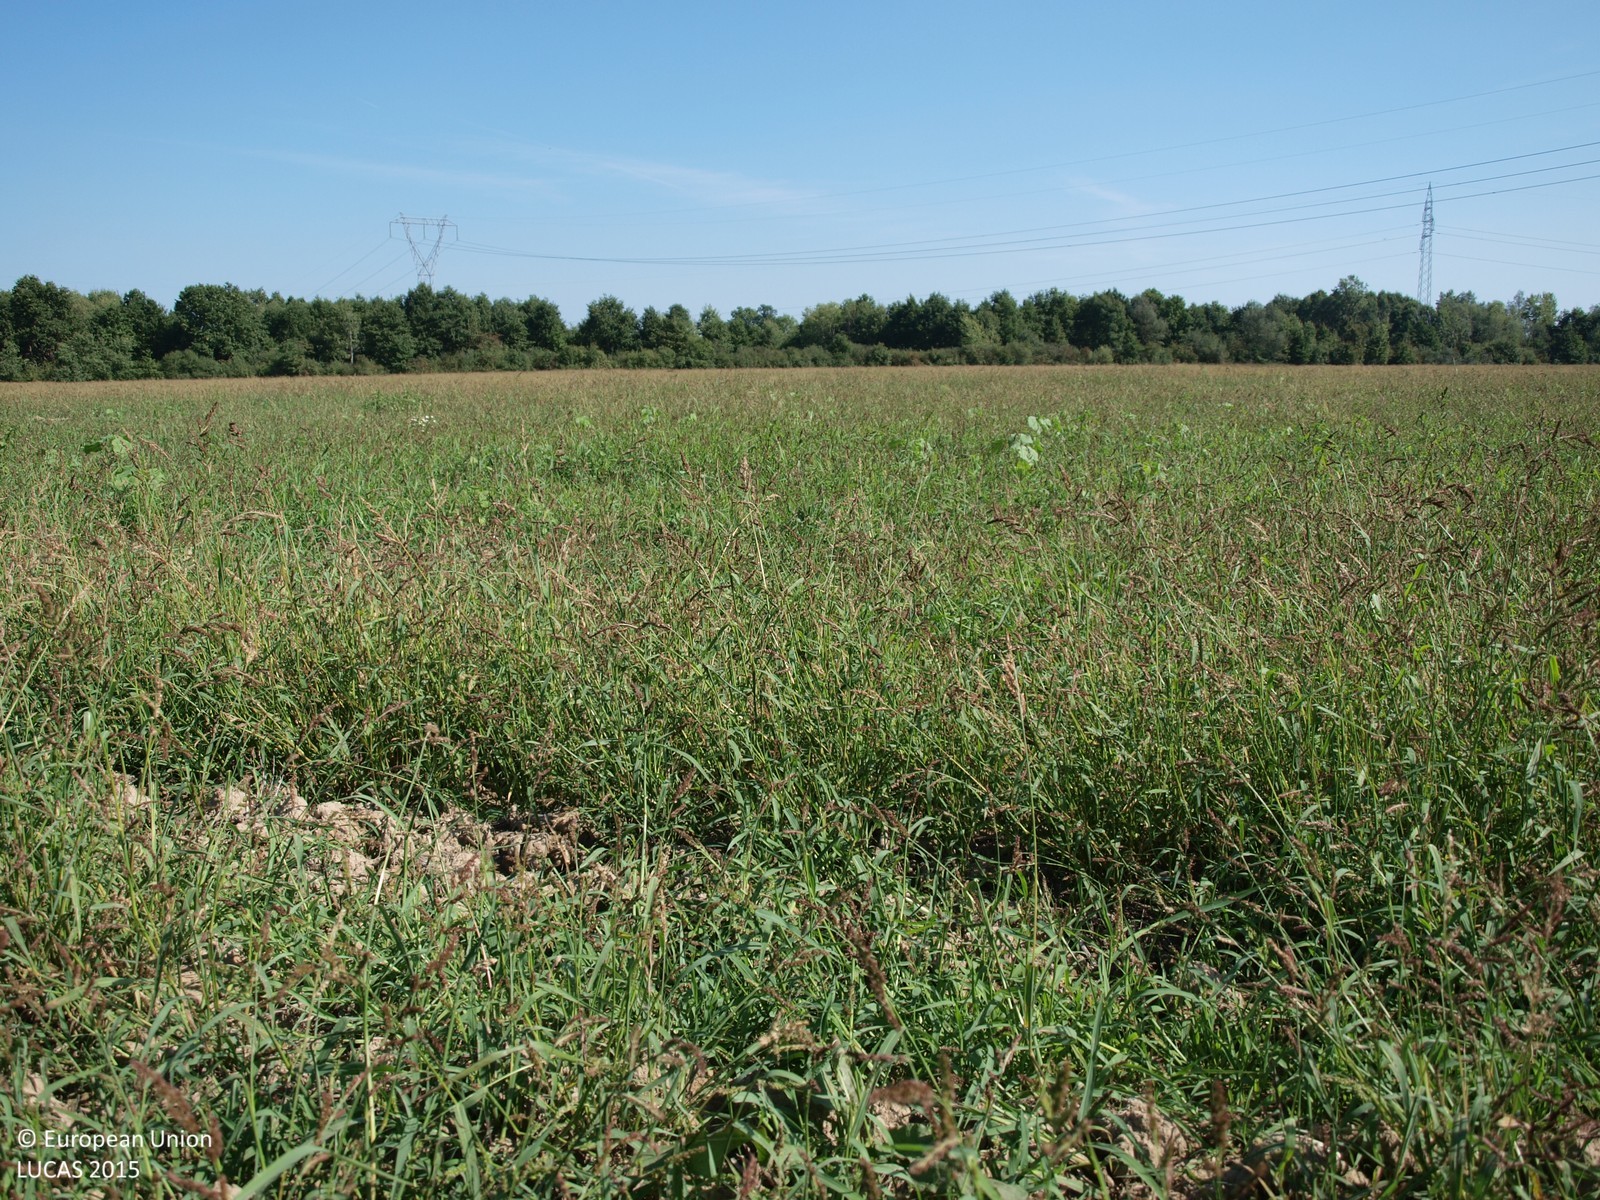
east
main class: Grassland
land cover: Grassland without tree/shrub cover
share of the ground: > 75 %
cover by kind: herbaceous plants 100 %
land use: Agriculture (excluding fallow land and kitchen gardens)
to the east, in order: Grassland without tree/shrub cover; Ditches and canals; Broadleaved woodland
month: September
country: HR
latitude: 45.6536
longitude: 16.0932
